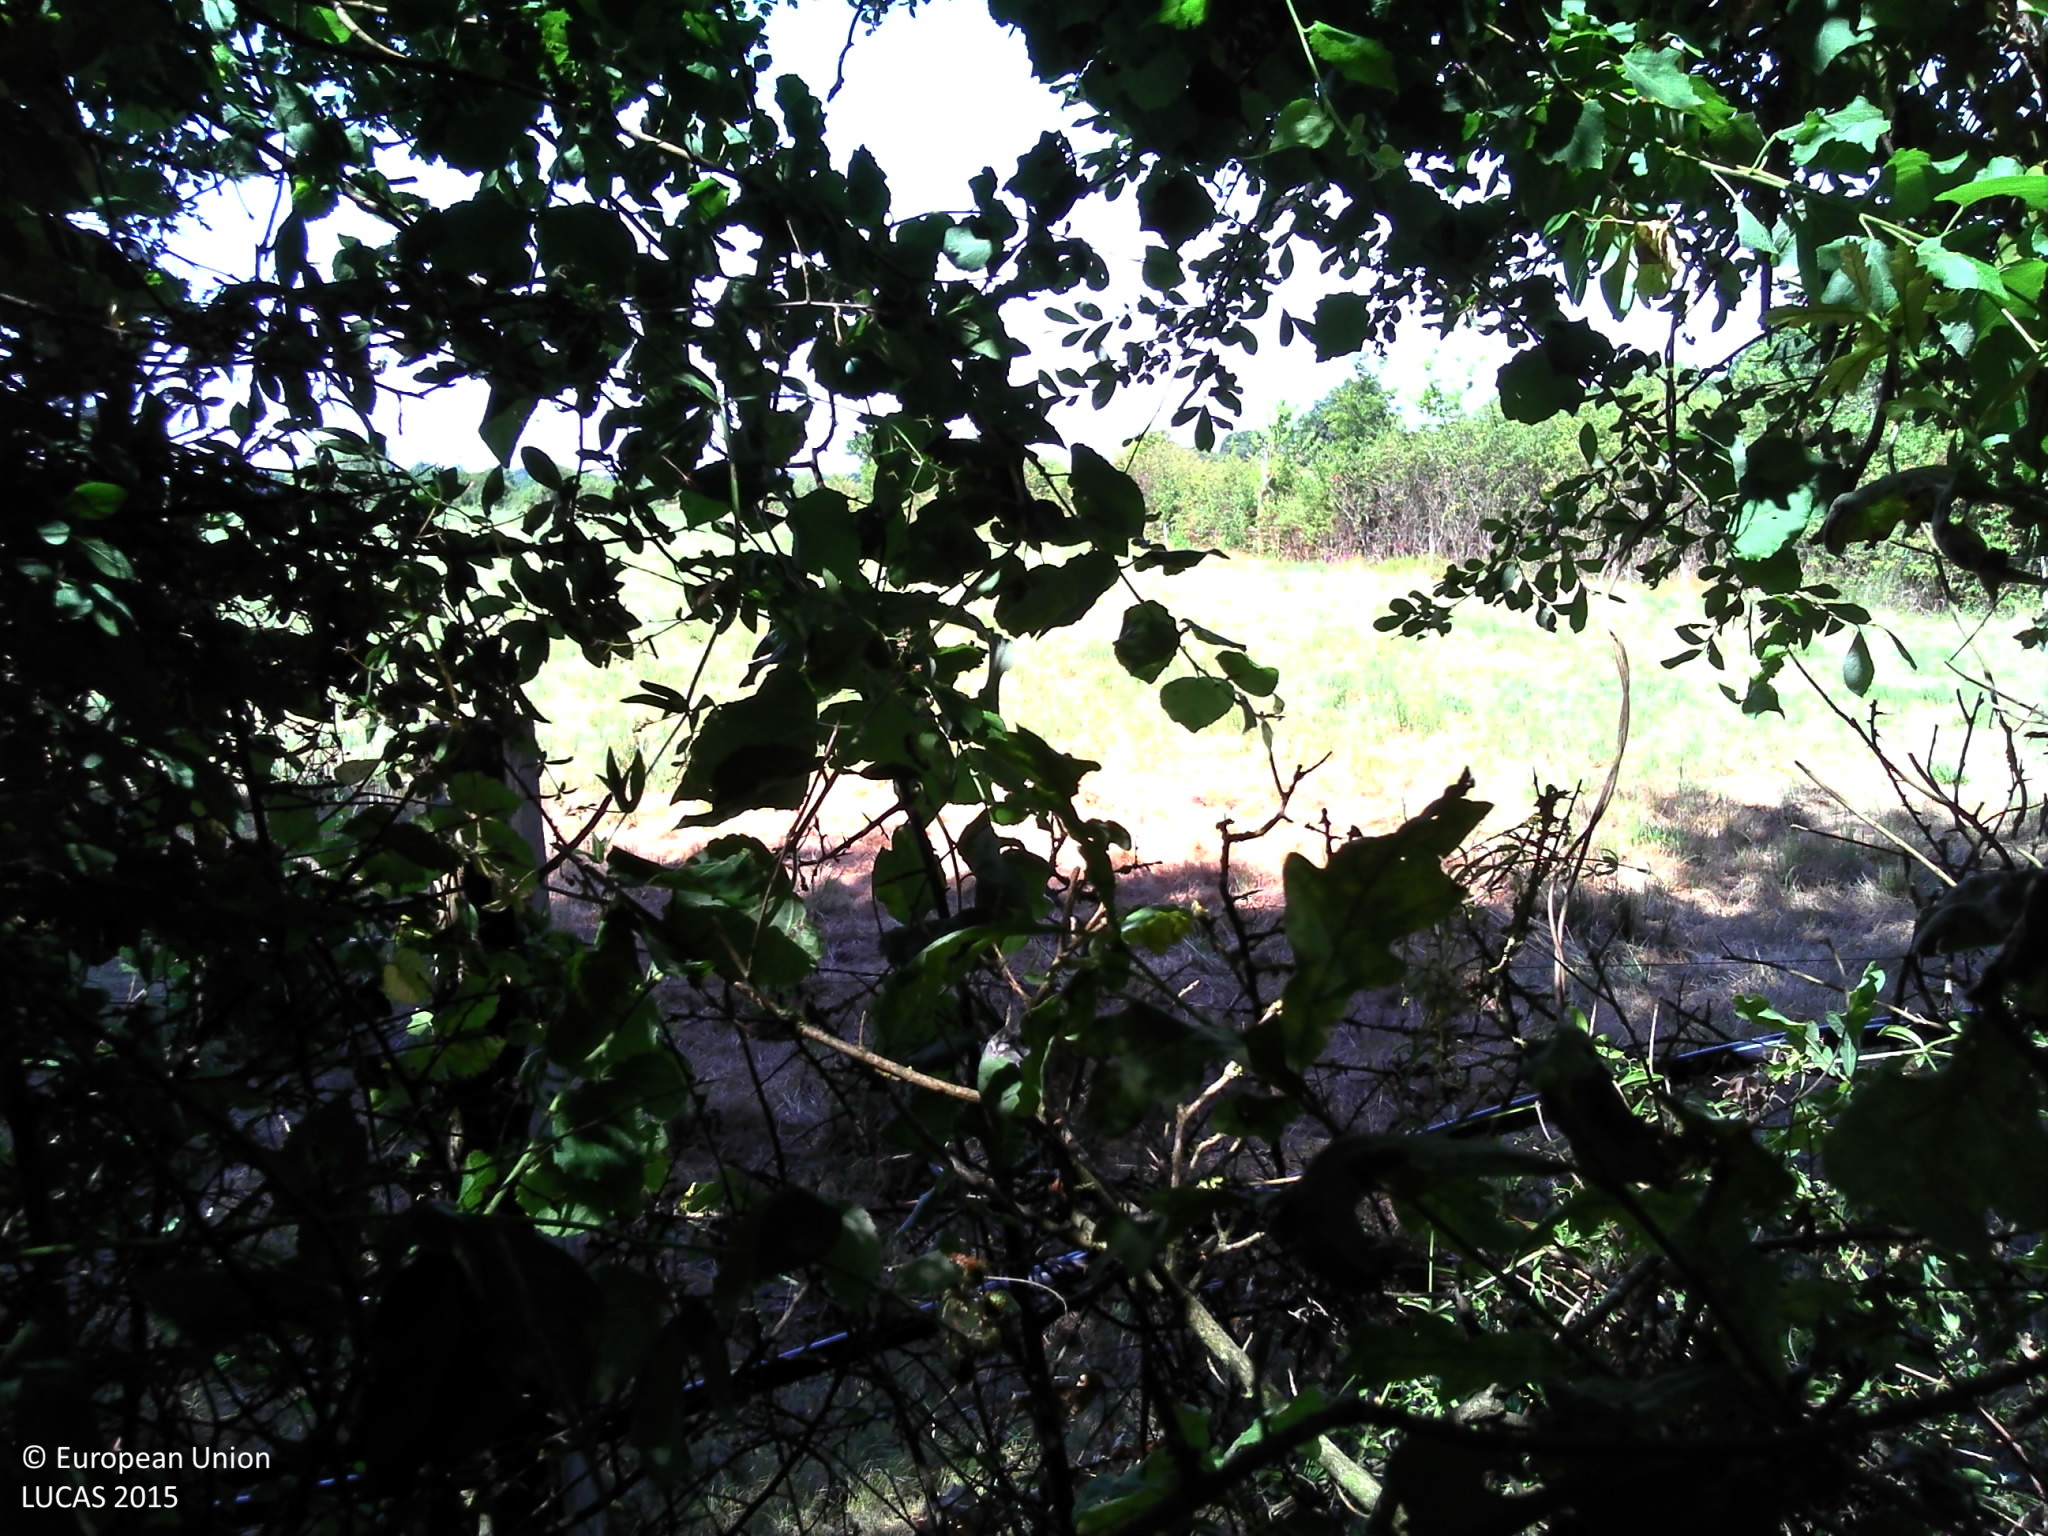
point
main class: Grassland
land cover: Grassland without tree/shrub cover
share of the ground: > 75 %
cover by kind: herbaceous plants 100 %
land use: Agriculture (excluding fallow land and kitchen gardens)
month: July
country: FR
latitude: 46.2073
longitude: 0.5878
